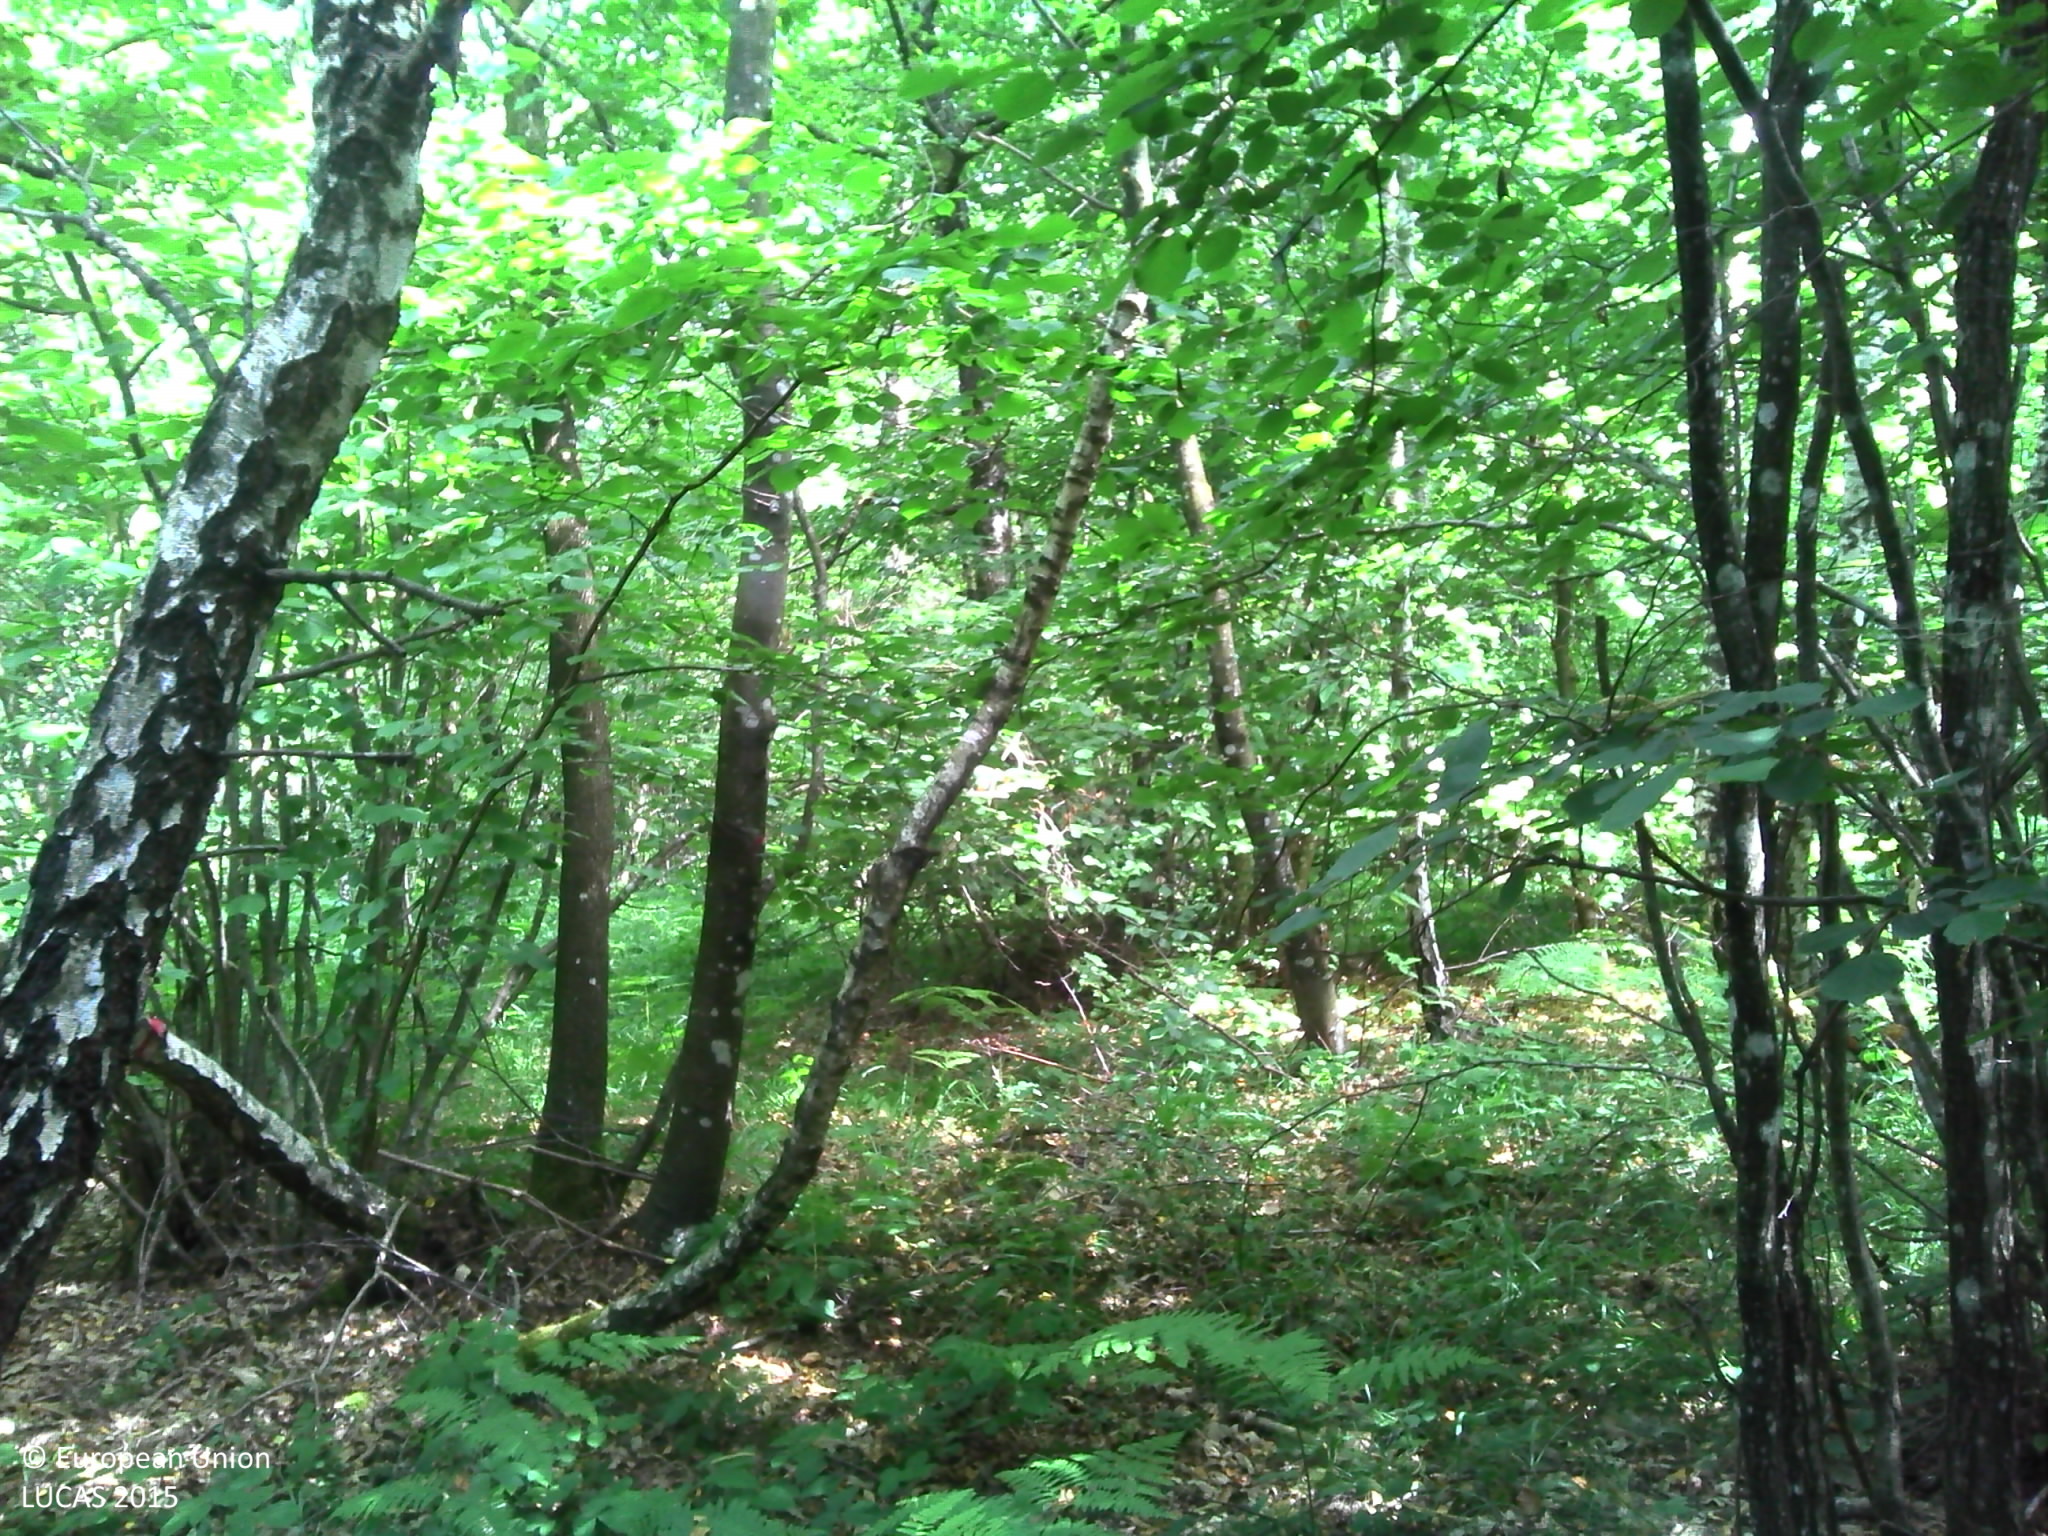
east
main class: Woodland
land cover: Broadleaved woodland
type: acidophilous oak and oak-birch forest
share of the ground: > 75 %
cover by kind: broadleaved forest trees 80 %, herbaceous plants 10 %, consolidated bare surface 10 %
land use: Forestry
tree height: > 5 m
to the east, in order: Broadleaved woodland; Tracks; Broadleaved woodland
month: July
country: FR
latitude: 45.2903
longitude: 5.2746
